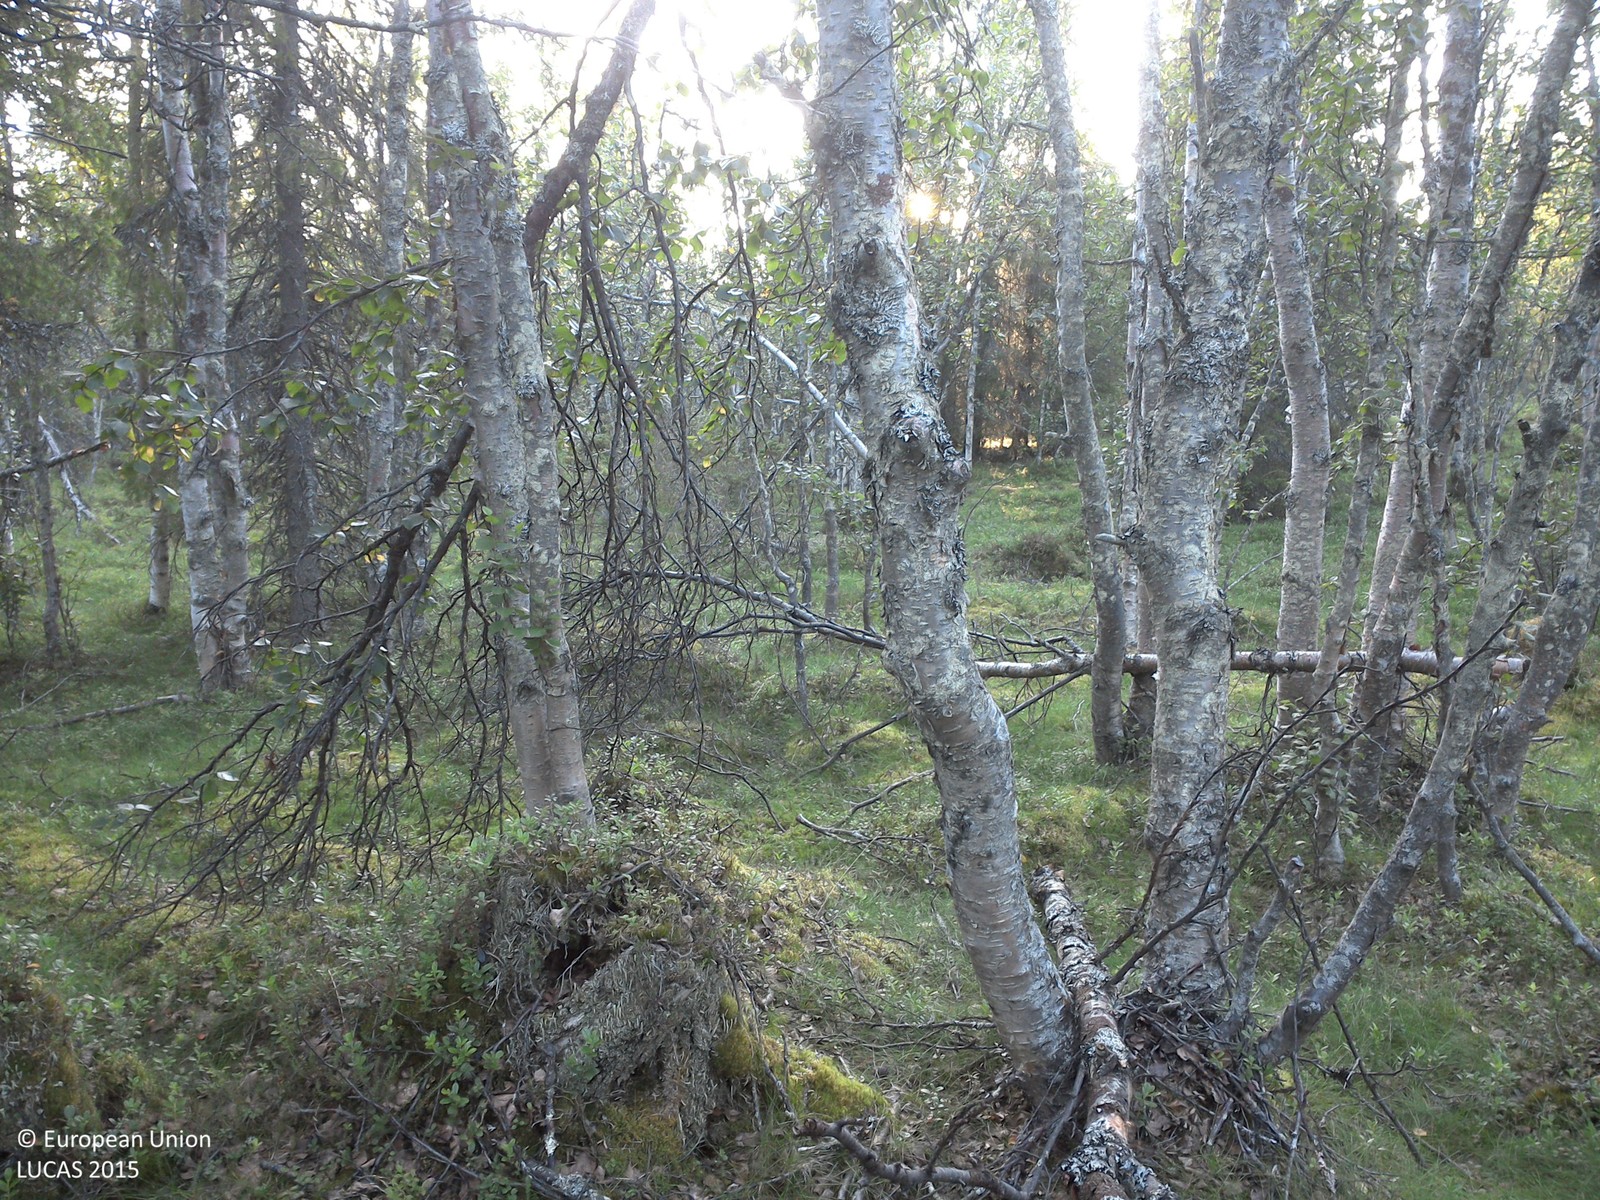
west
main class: Woodland
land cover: Spruce dominated mixed woodland
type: boreal forest
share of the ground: 25 - 50 %
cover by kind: shrubs 40 %, coniferous forest trees 20 %, lichens and mosses 20 %, broadleaved forest trees 15 %, herbaceous plants 5 %
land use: Forestry
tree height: > 5 m
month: August
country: SE
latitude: 67.3009
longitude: 21.1196
